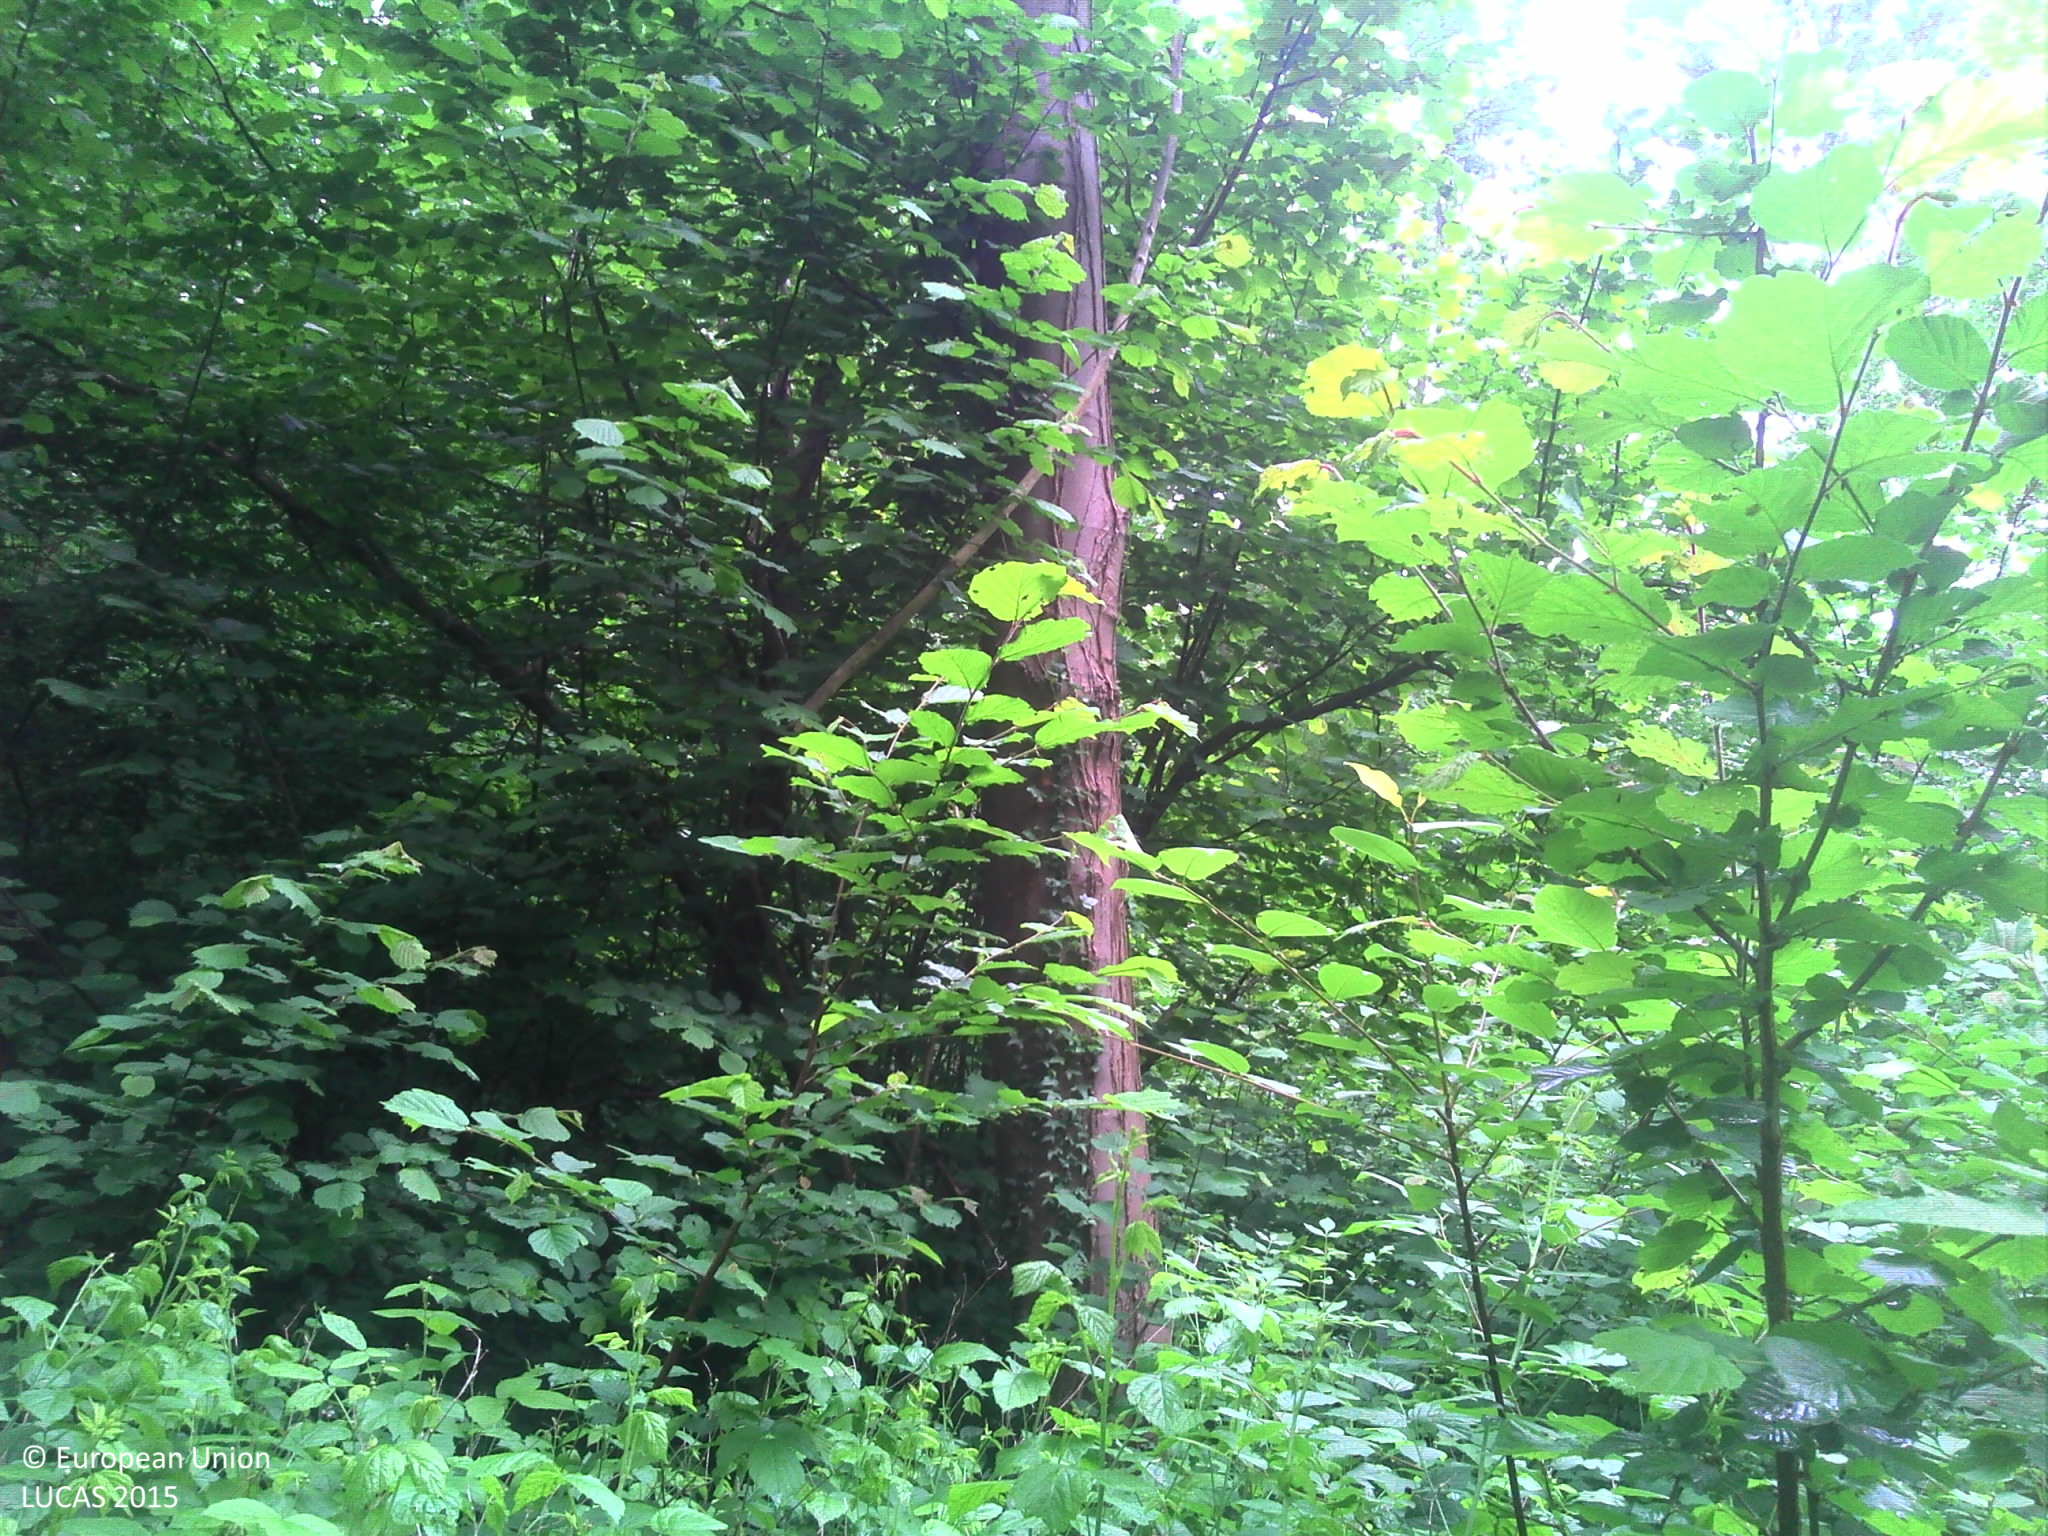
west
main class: Woodland
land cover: Broadleaved woodland
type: mesophytic deciduous forest
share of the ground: > 75 %
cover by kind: broadleaved forest trees 90 %, herbaceous plants 10 %
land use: Forestry
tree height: > 5 m
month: May
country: FR
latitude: 48.2704
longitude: 7.6432
